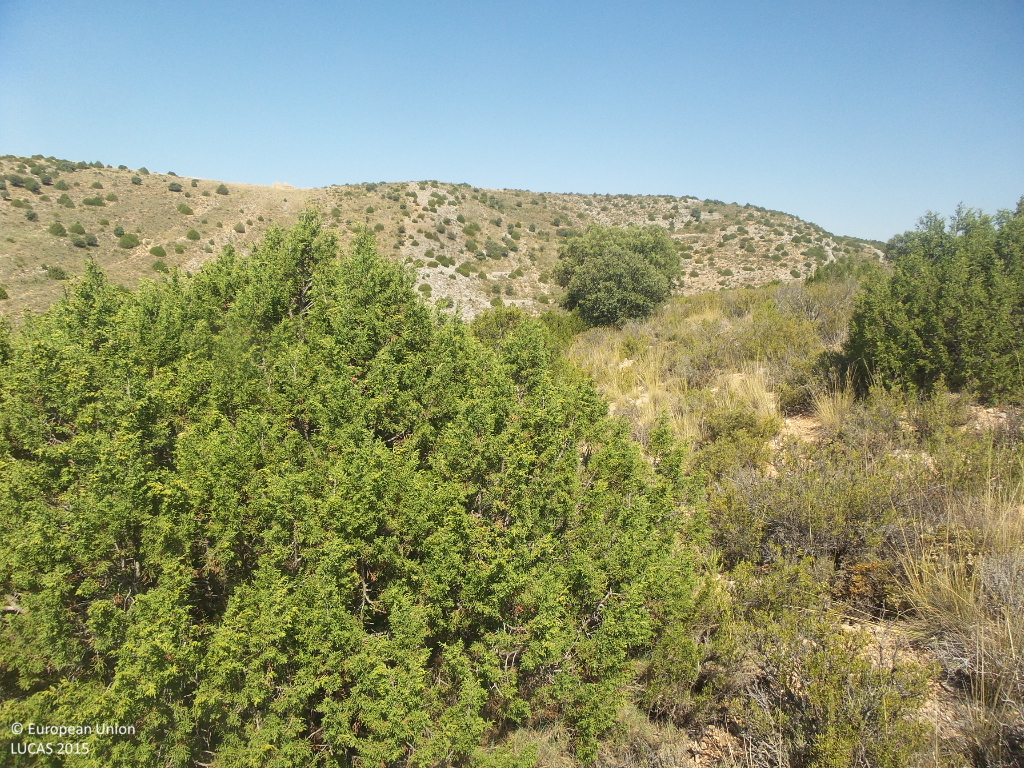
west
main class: Shrubland
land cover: Shrubland without tree cover
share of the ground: 50 - 75 %
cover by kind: shrubs 60 %, unconsolidated bare surface 35 %, herbaceous plants 5 %
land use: Semi-natural and natural areas not in use
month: July
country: ES
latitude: 41.1466
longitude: -1.9048
